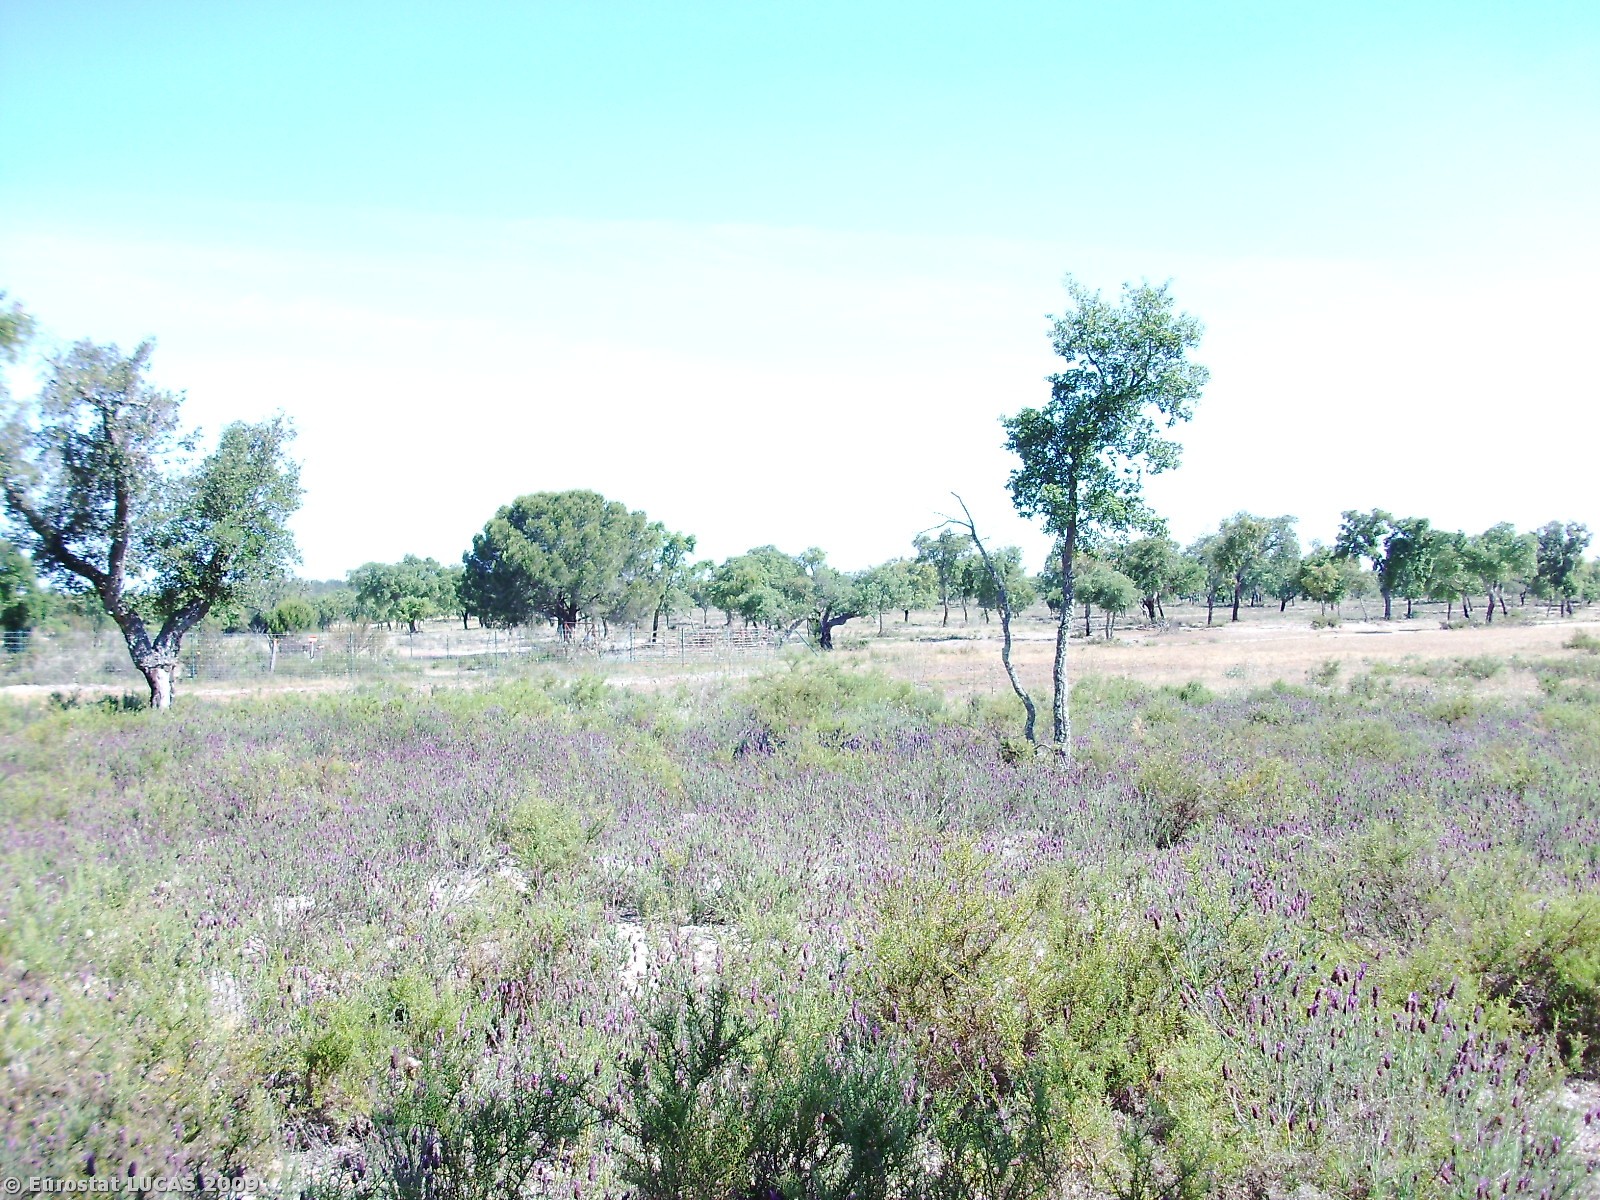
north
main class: Woodland
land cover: Broadleaved woodland
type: broadleaved evergreen forest
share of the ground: 50 - 75 %
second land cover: Shrubland with sparse tree cover
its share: 25 - 50 %
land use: Forestry
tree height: > 5 m
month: May
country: PT
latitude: 39.1941
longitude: -7.9169
